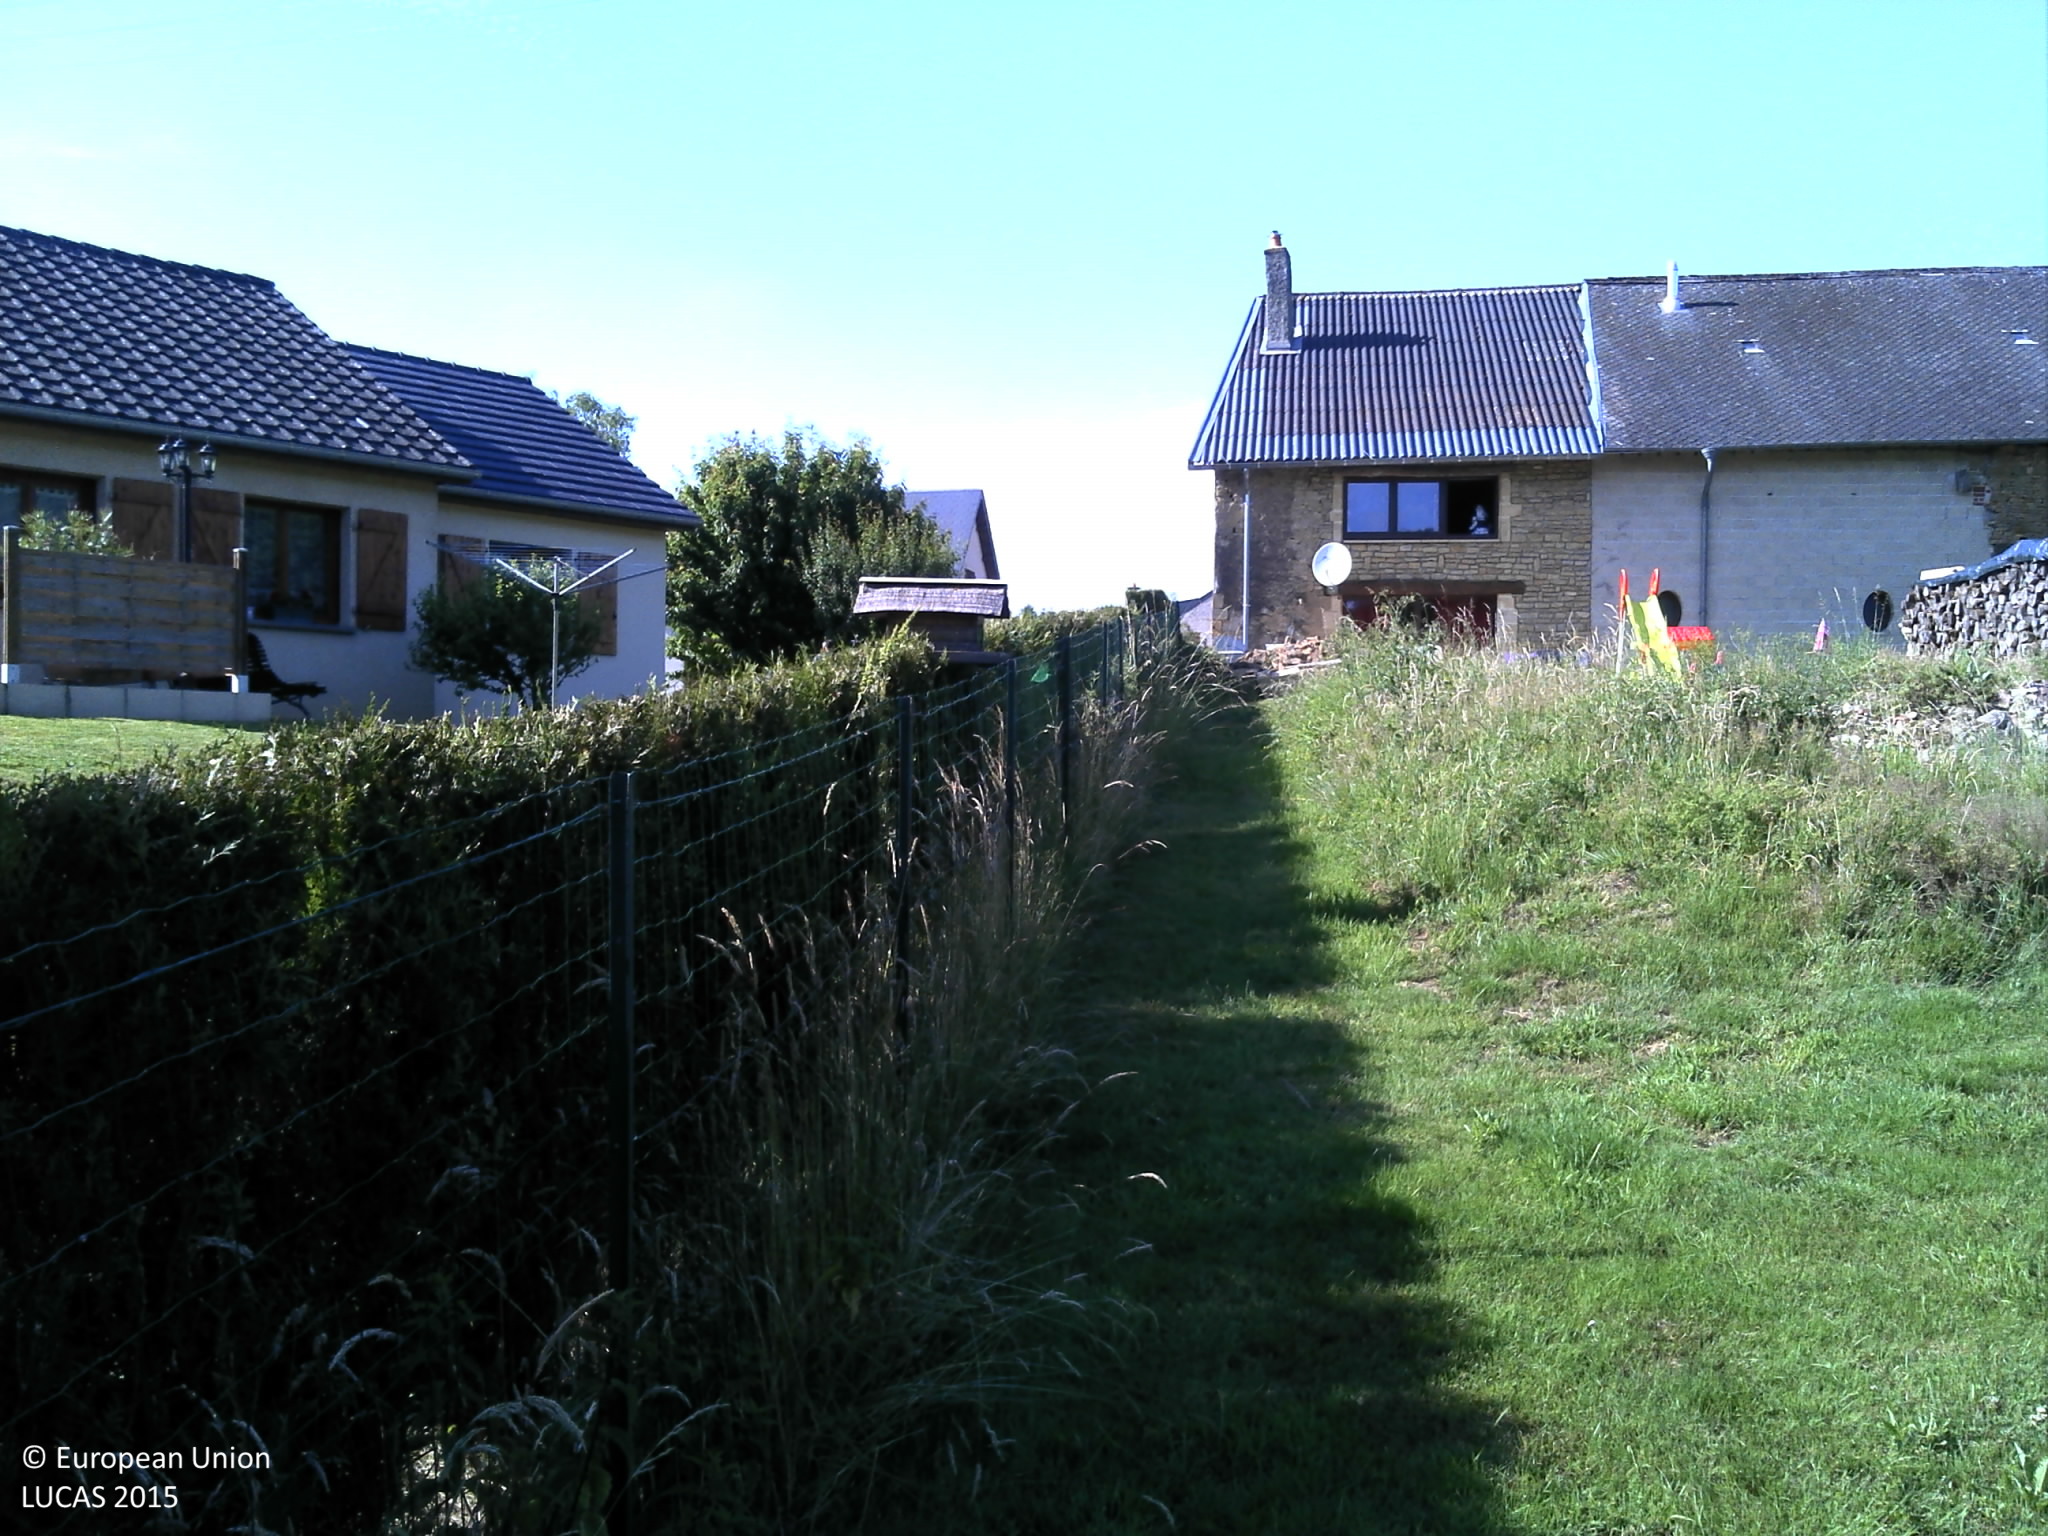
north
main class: Grassland
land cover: Grassland without tree/shrub cover
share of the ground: > 75 %
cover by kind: herbaceous plants 100 %
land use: Residential
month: June
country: FR
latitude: 49.6983
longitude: 5.0480
